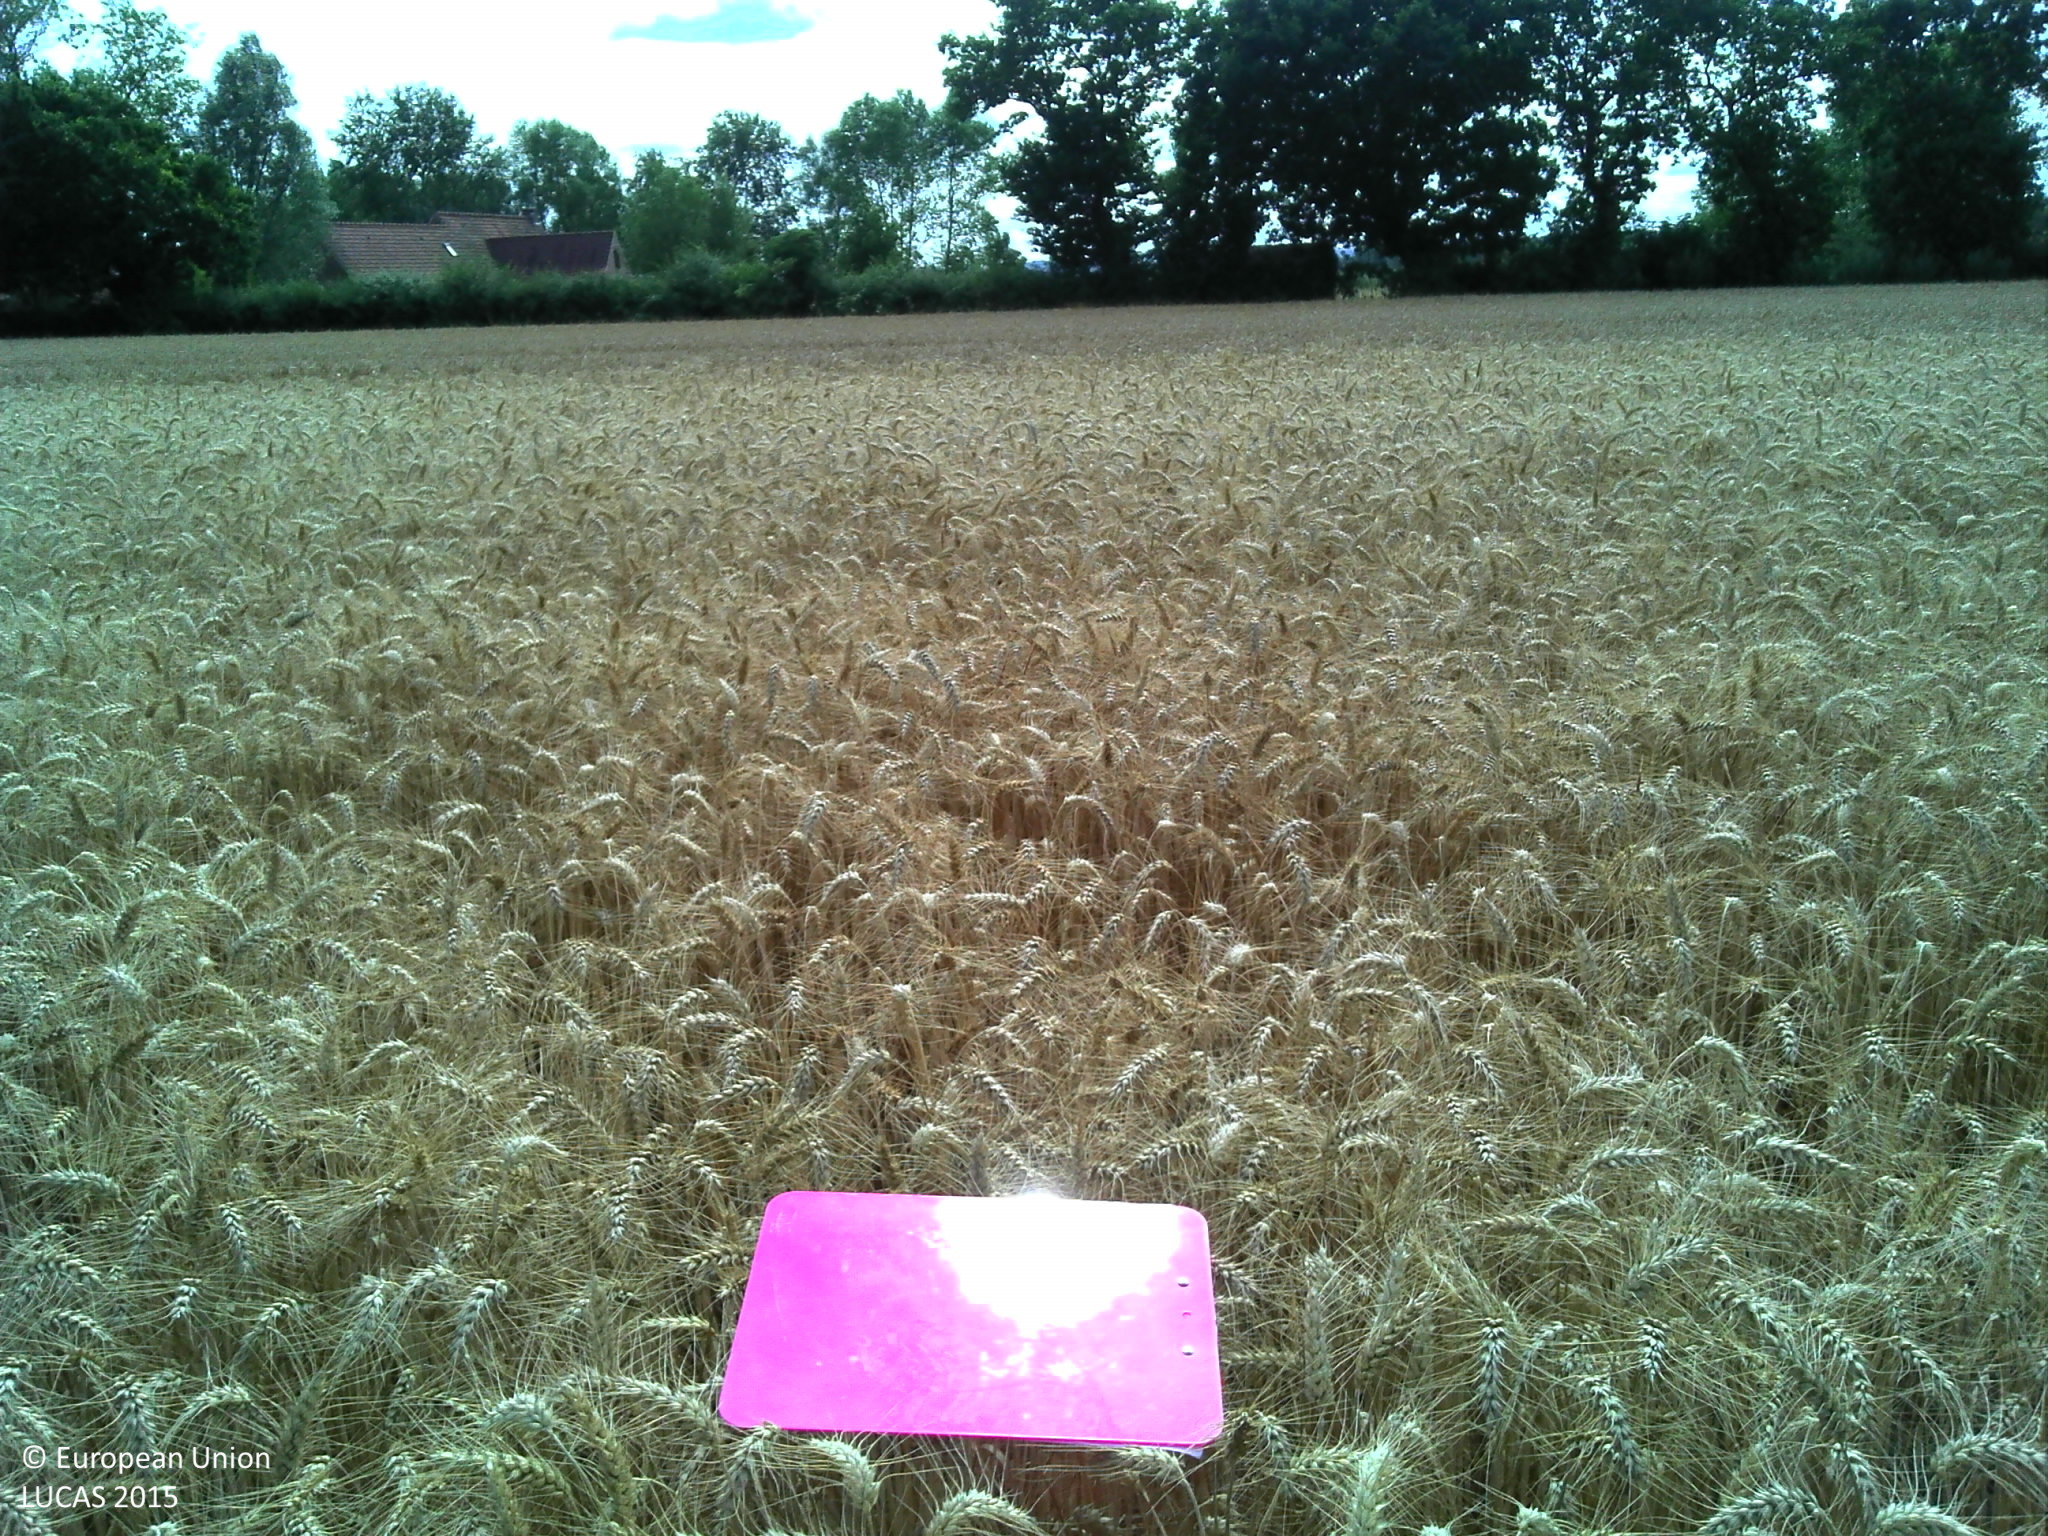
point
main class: Cropland
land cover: Durum wheat
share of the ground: > 75 %
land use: Agriculture (excluding fallow land and kitchen gardens)
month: July
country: FR
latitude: 50.7933
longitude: 2.3397
